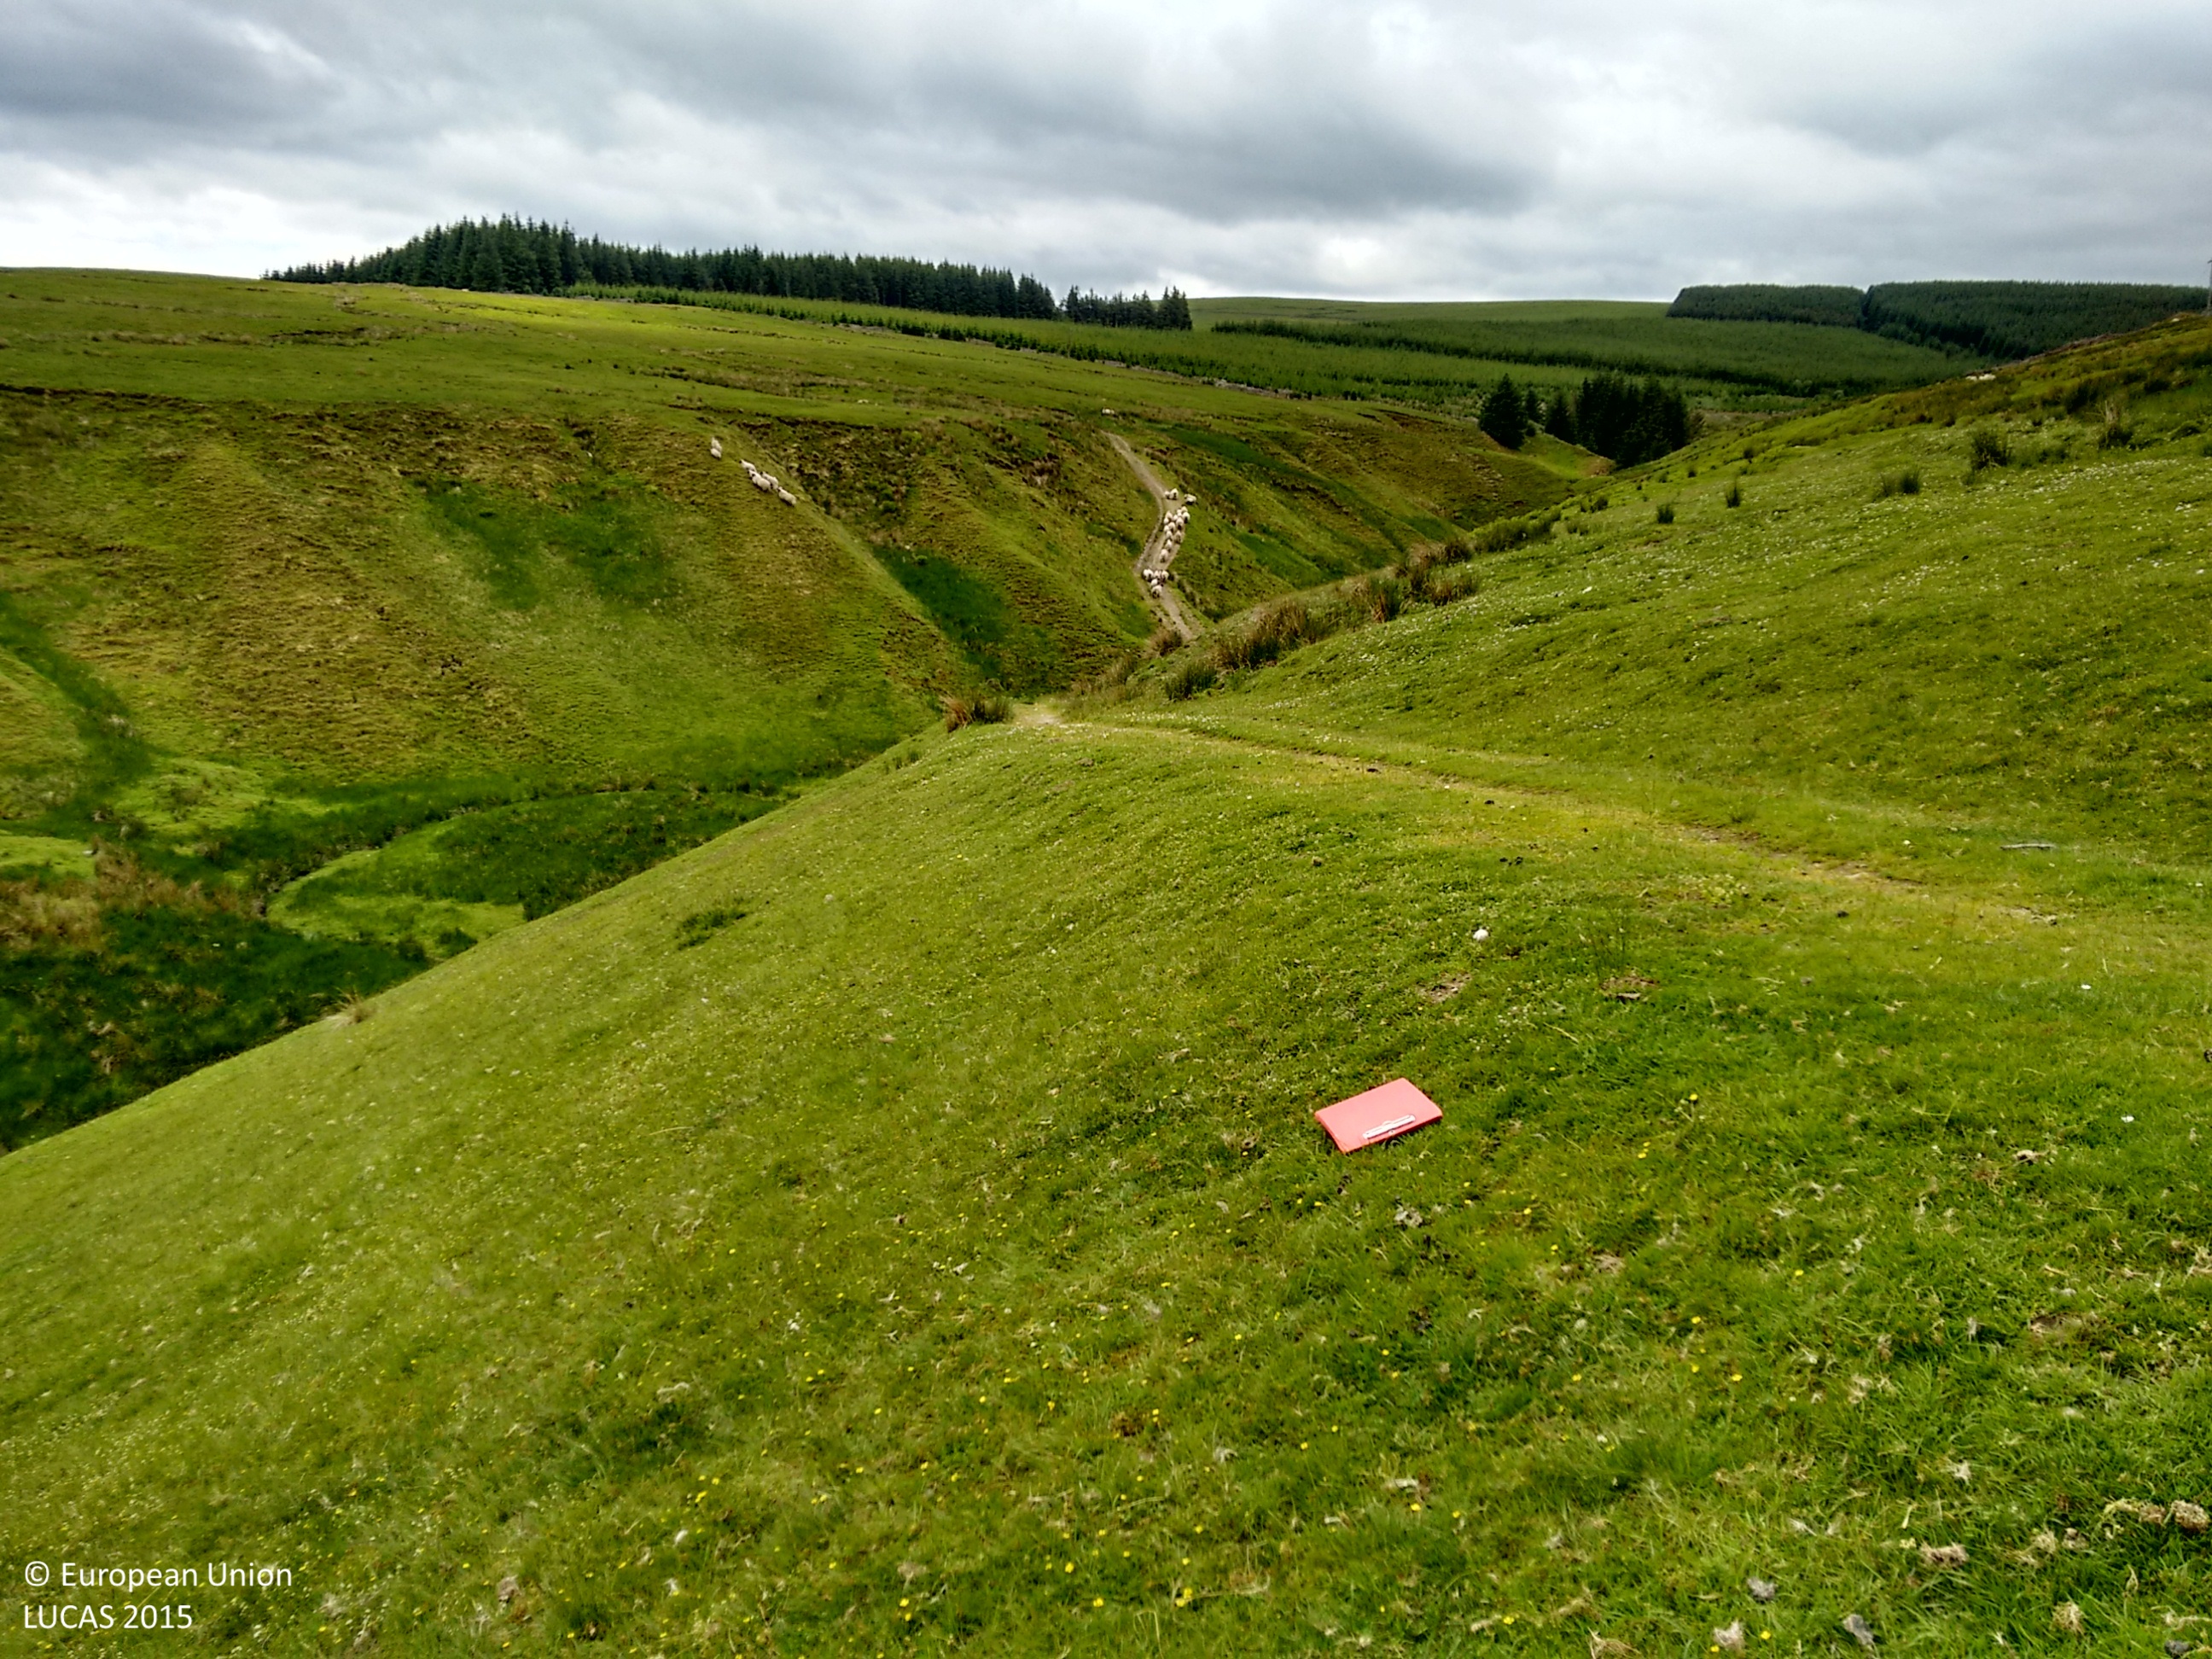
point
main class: Grassland
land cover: Grassland without tree/shrub cover
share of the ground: > 75 %
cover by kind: herbaceous plants 100 %
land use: Agriculture (excluding fallow land and kitchen gardens)
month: June
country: GB
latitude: 55.4316
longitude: -3.8510
